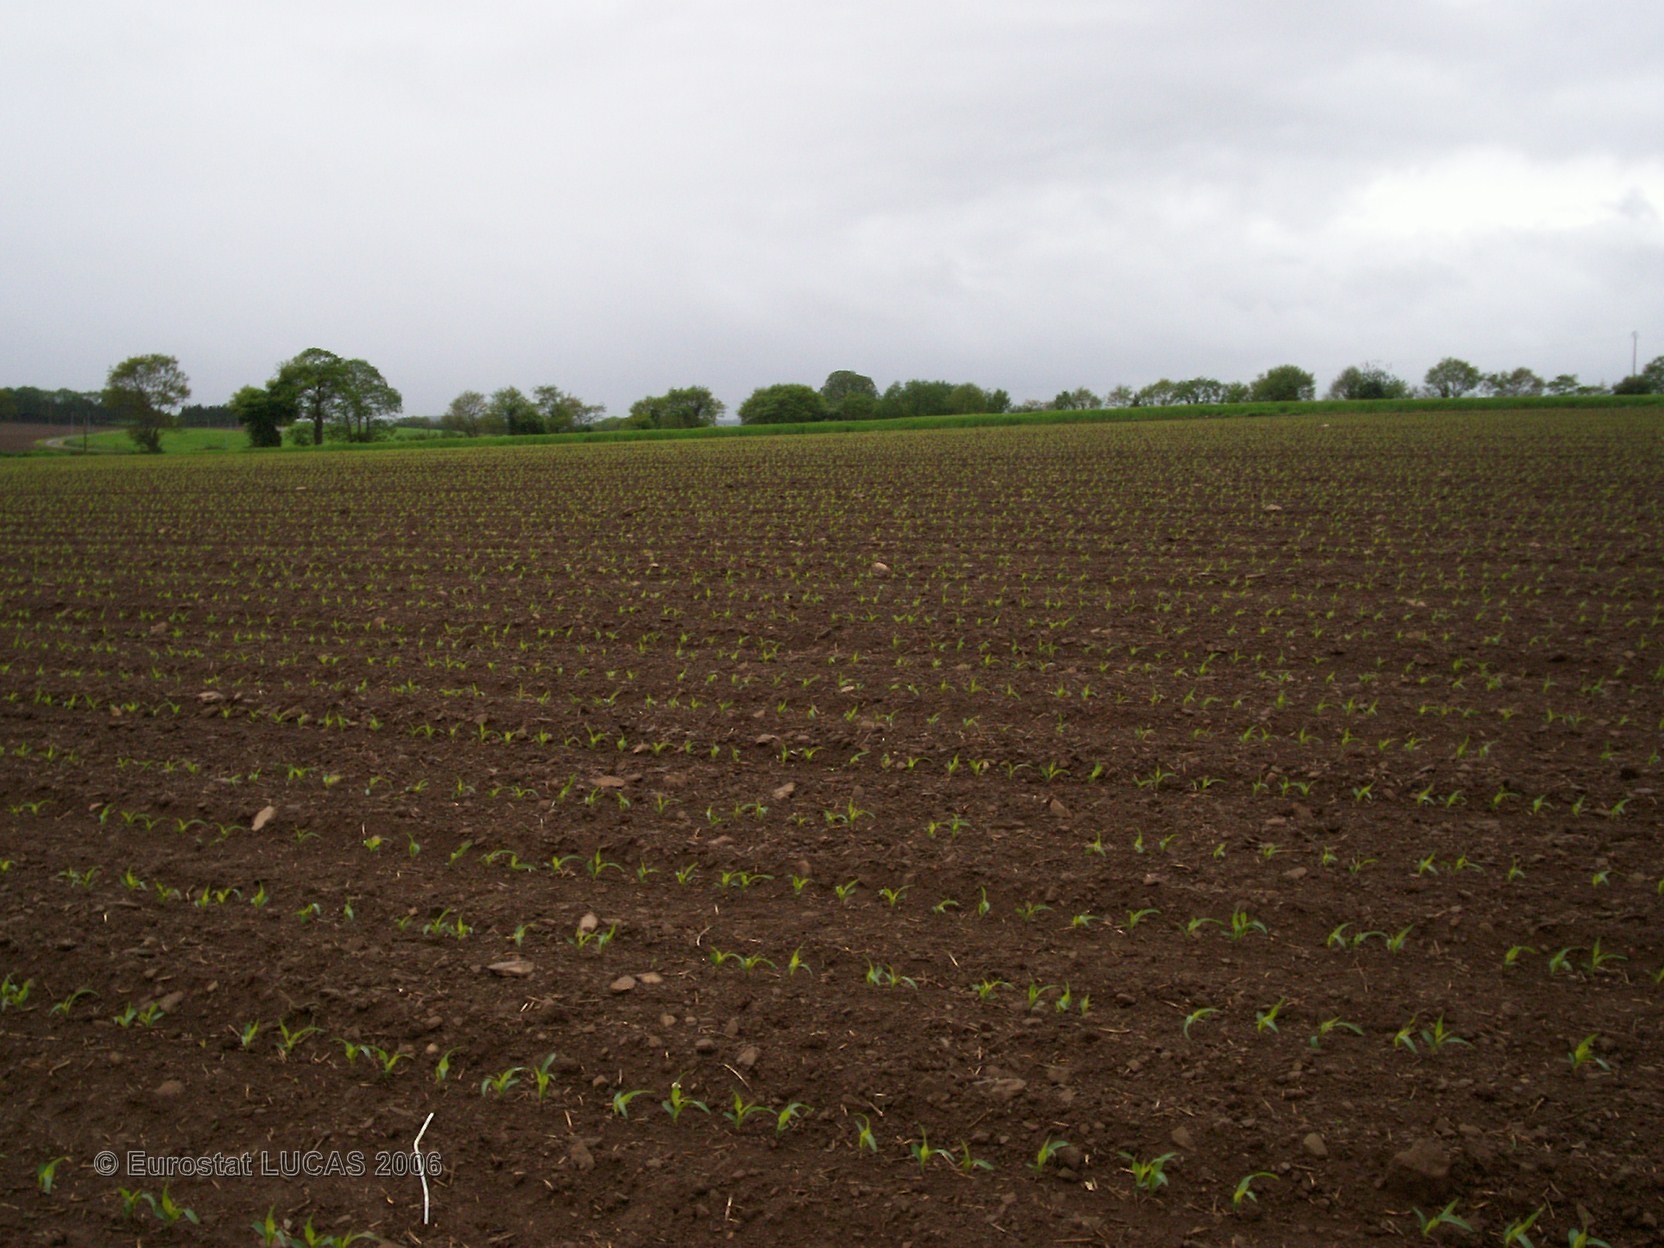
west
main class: Cropland
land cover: Maize
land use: Agriculture (excluding fallow land and kitchen gardens)
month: May
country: FR
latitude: 48.2994
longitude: -3.6560
